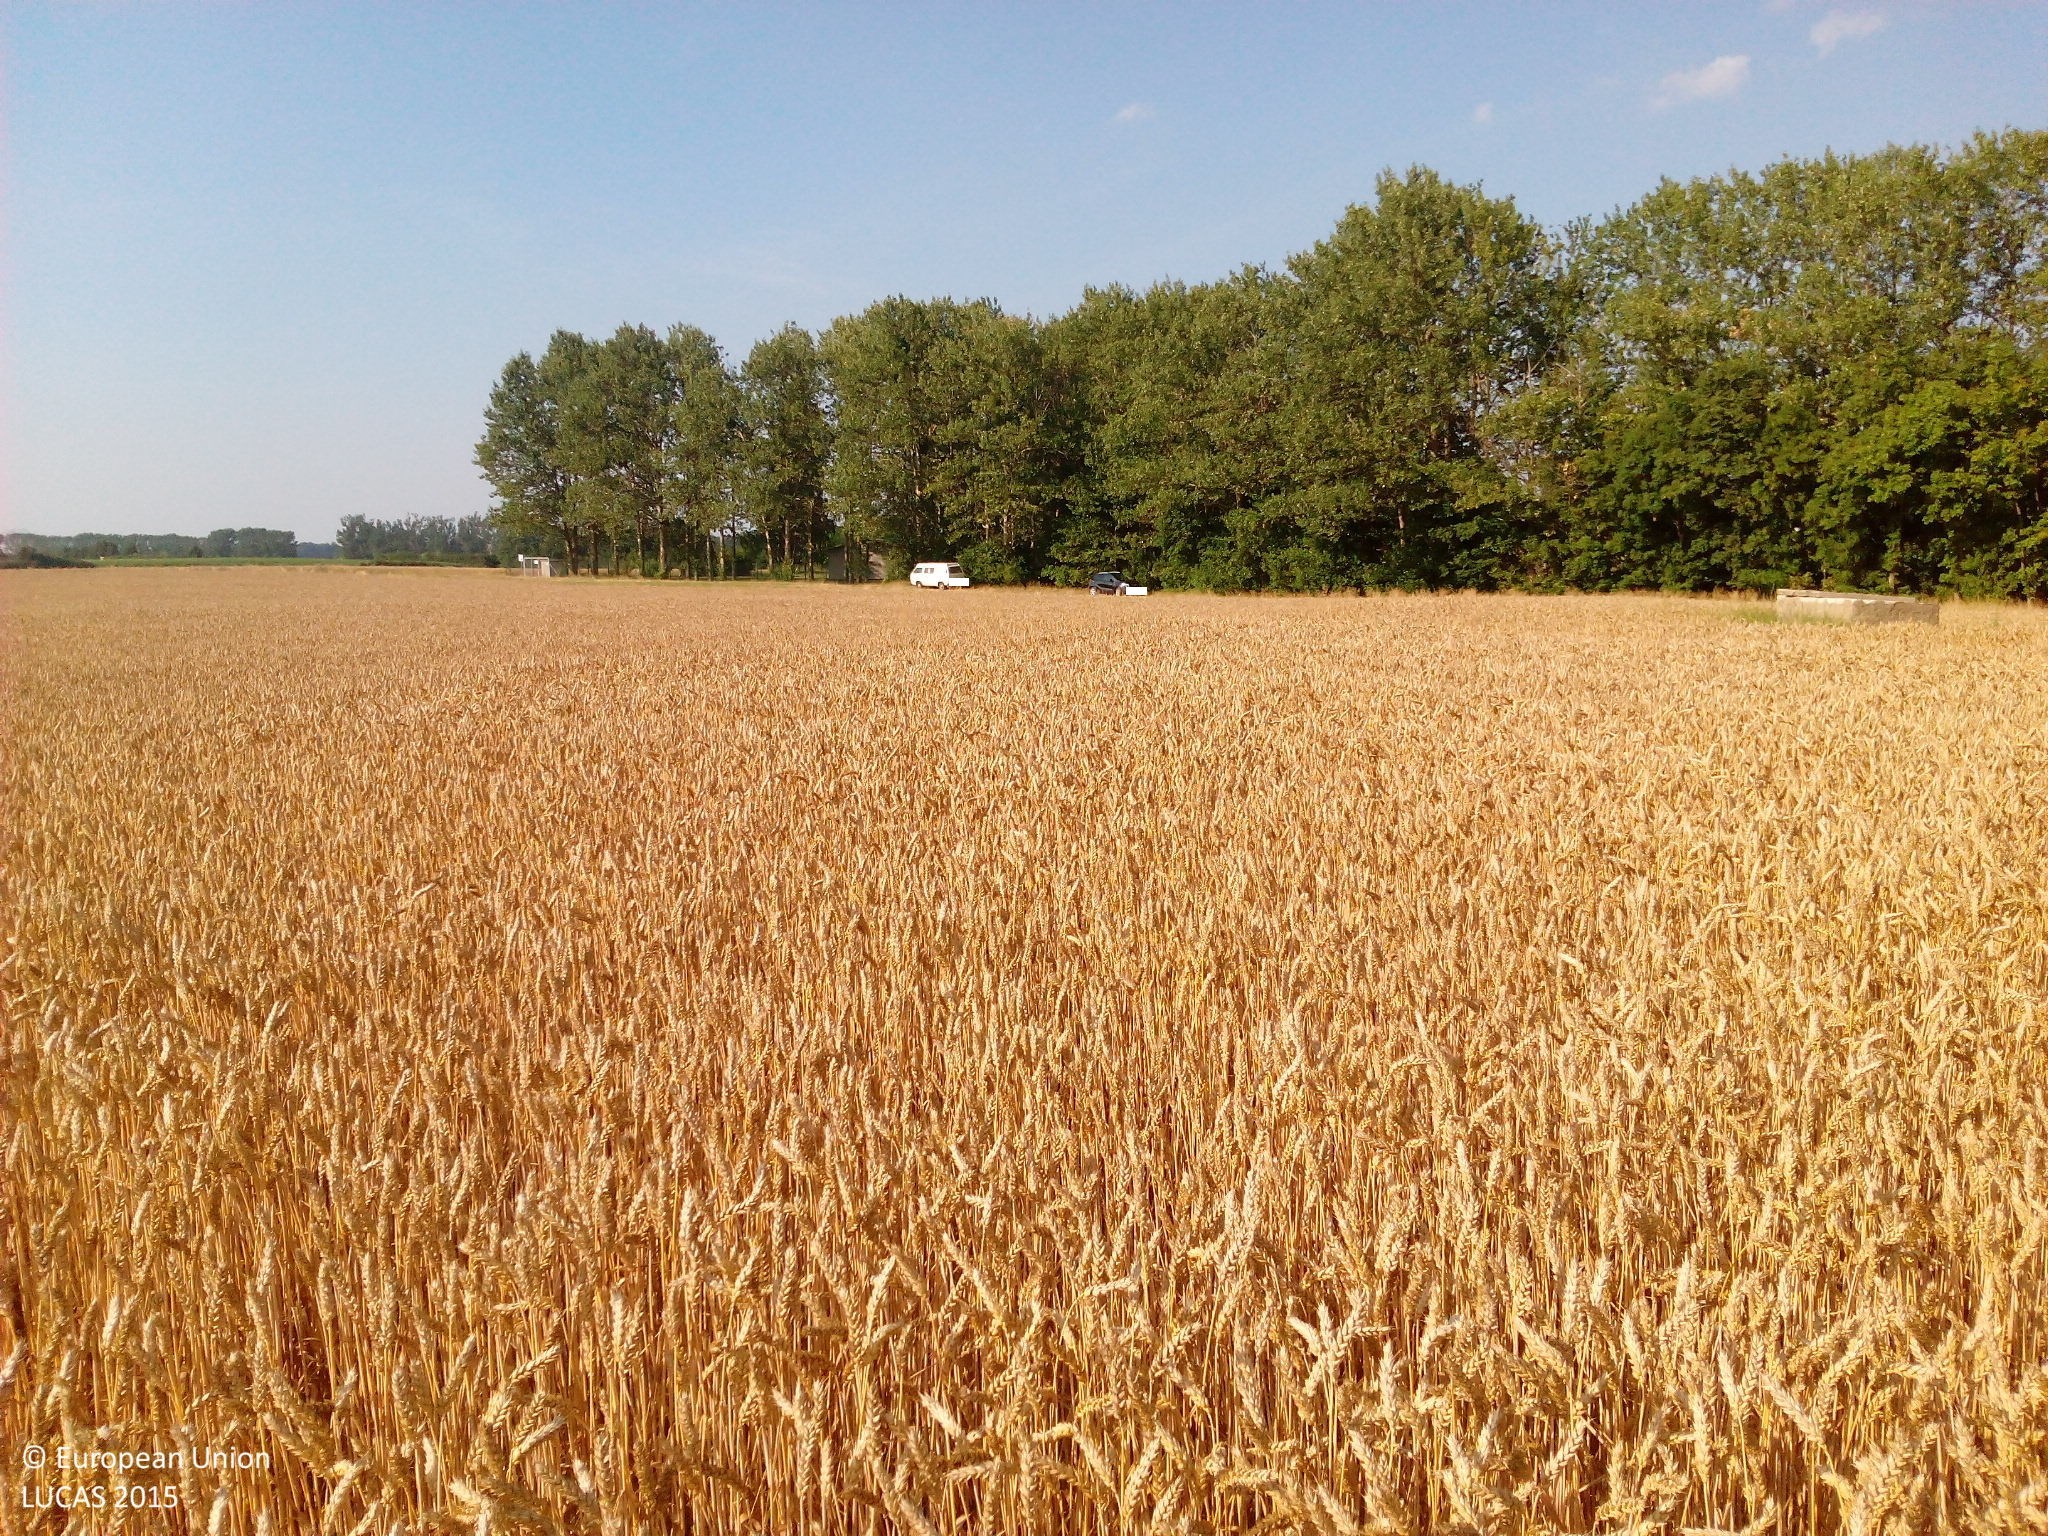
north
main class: Cropland
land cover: Common wheat
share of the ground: > 75 %
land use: Agriculture (excluding fallow land and kitchen gardens)
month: August
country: DE
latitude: 53.6180
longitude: 13.6129
